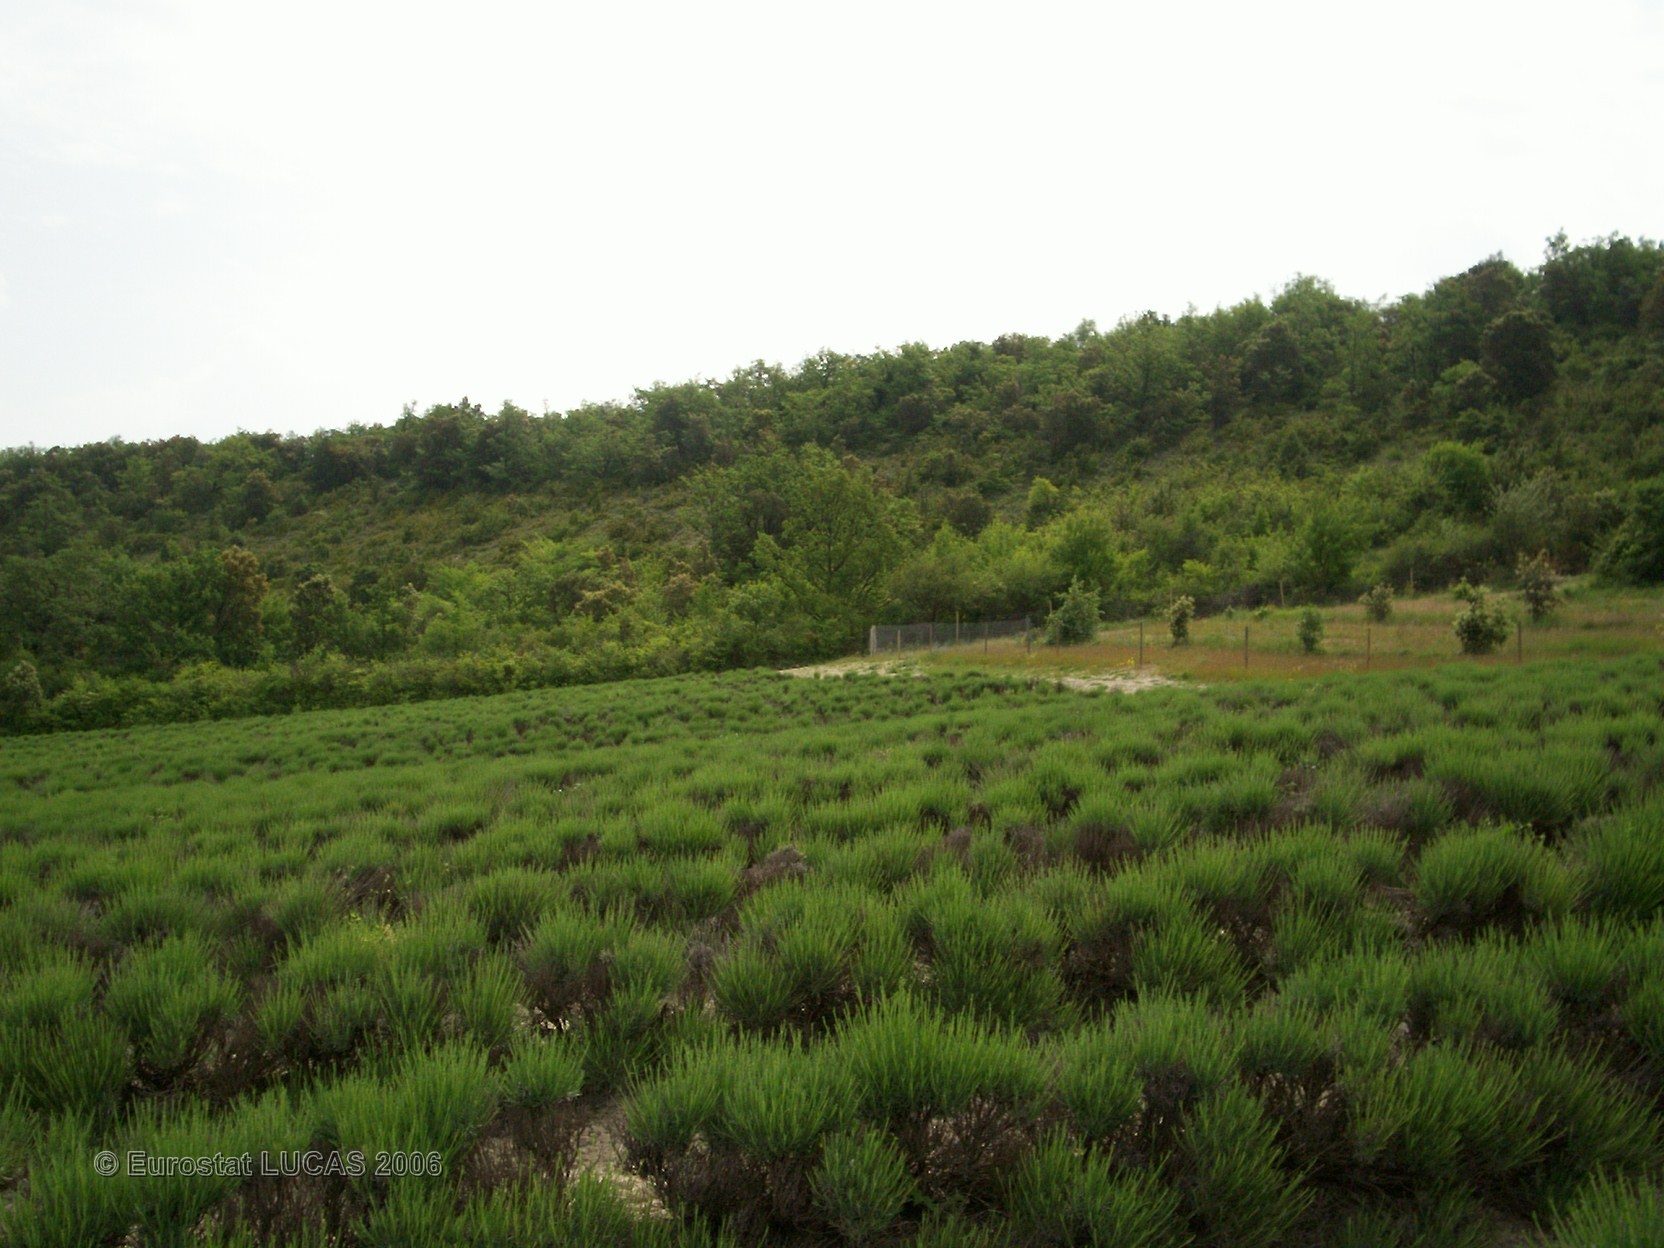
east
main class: Cropland
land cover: Permanent industrial crops
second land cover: Bare land
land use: Agriculture (excluding fallow land and kitchen gardens)
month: May
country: FR
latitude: 44.4032
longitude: 4.8466
